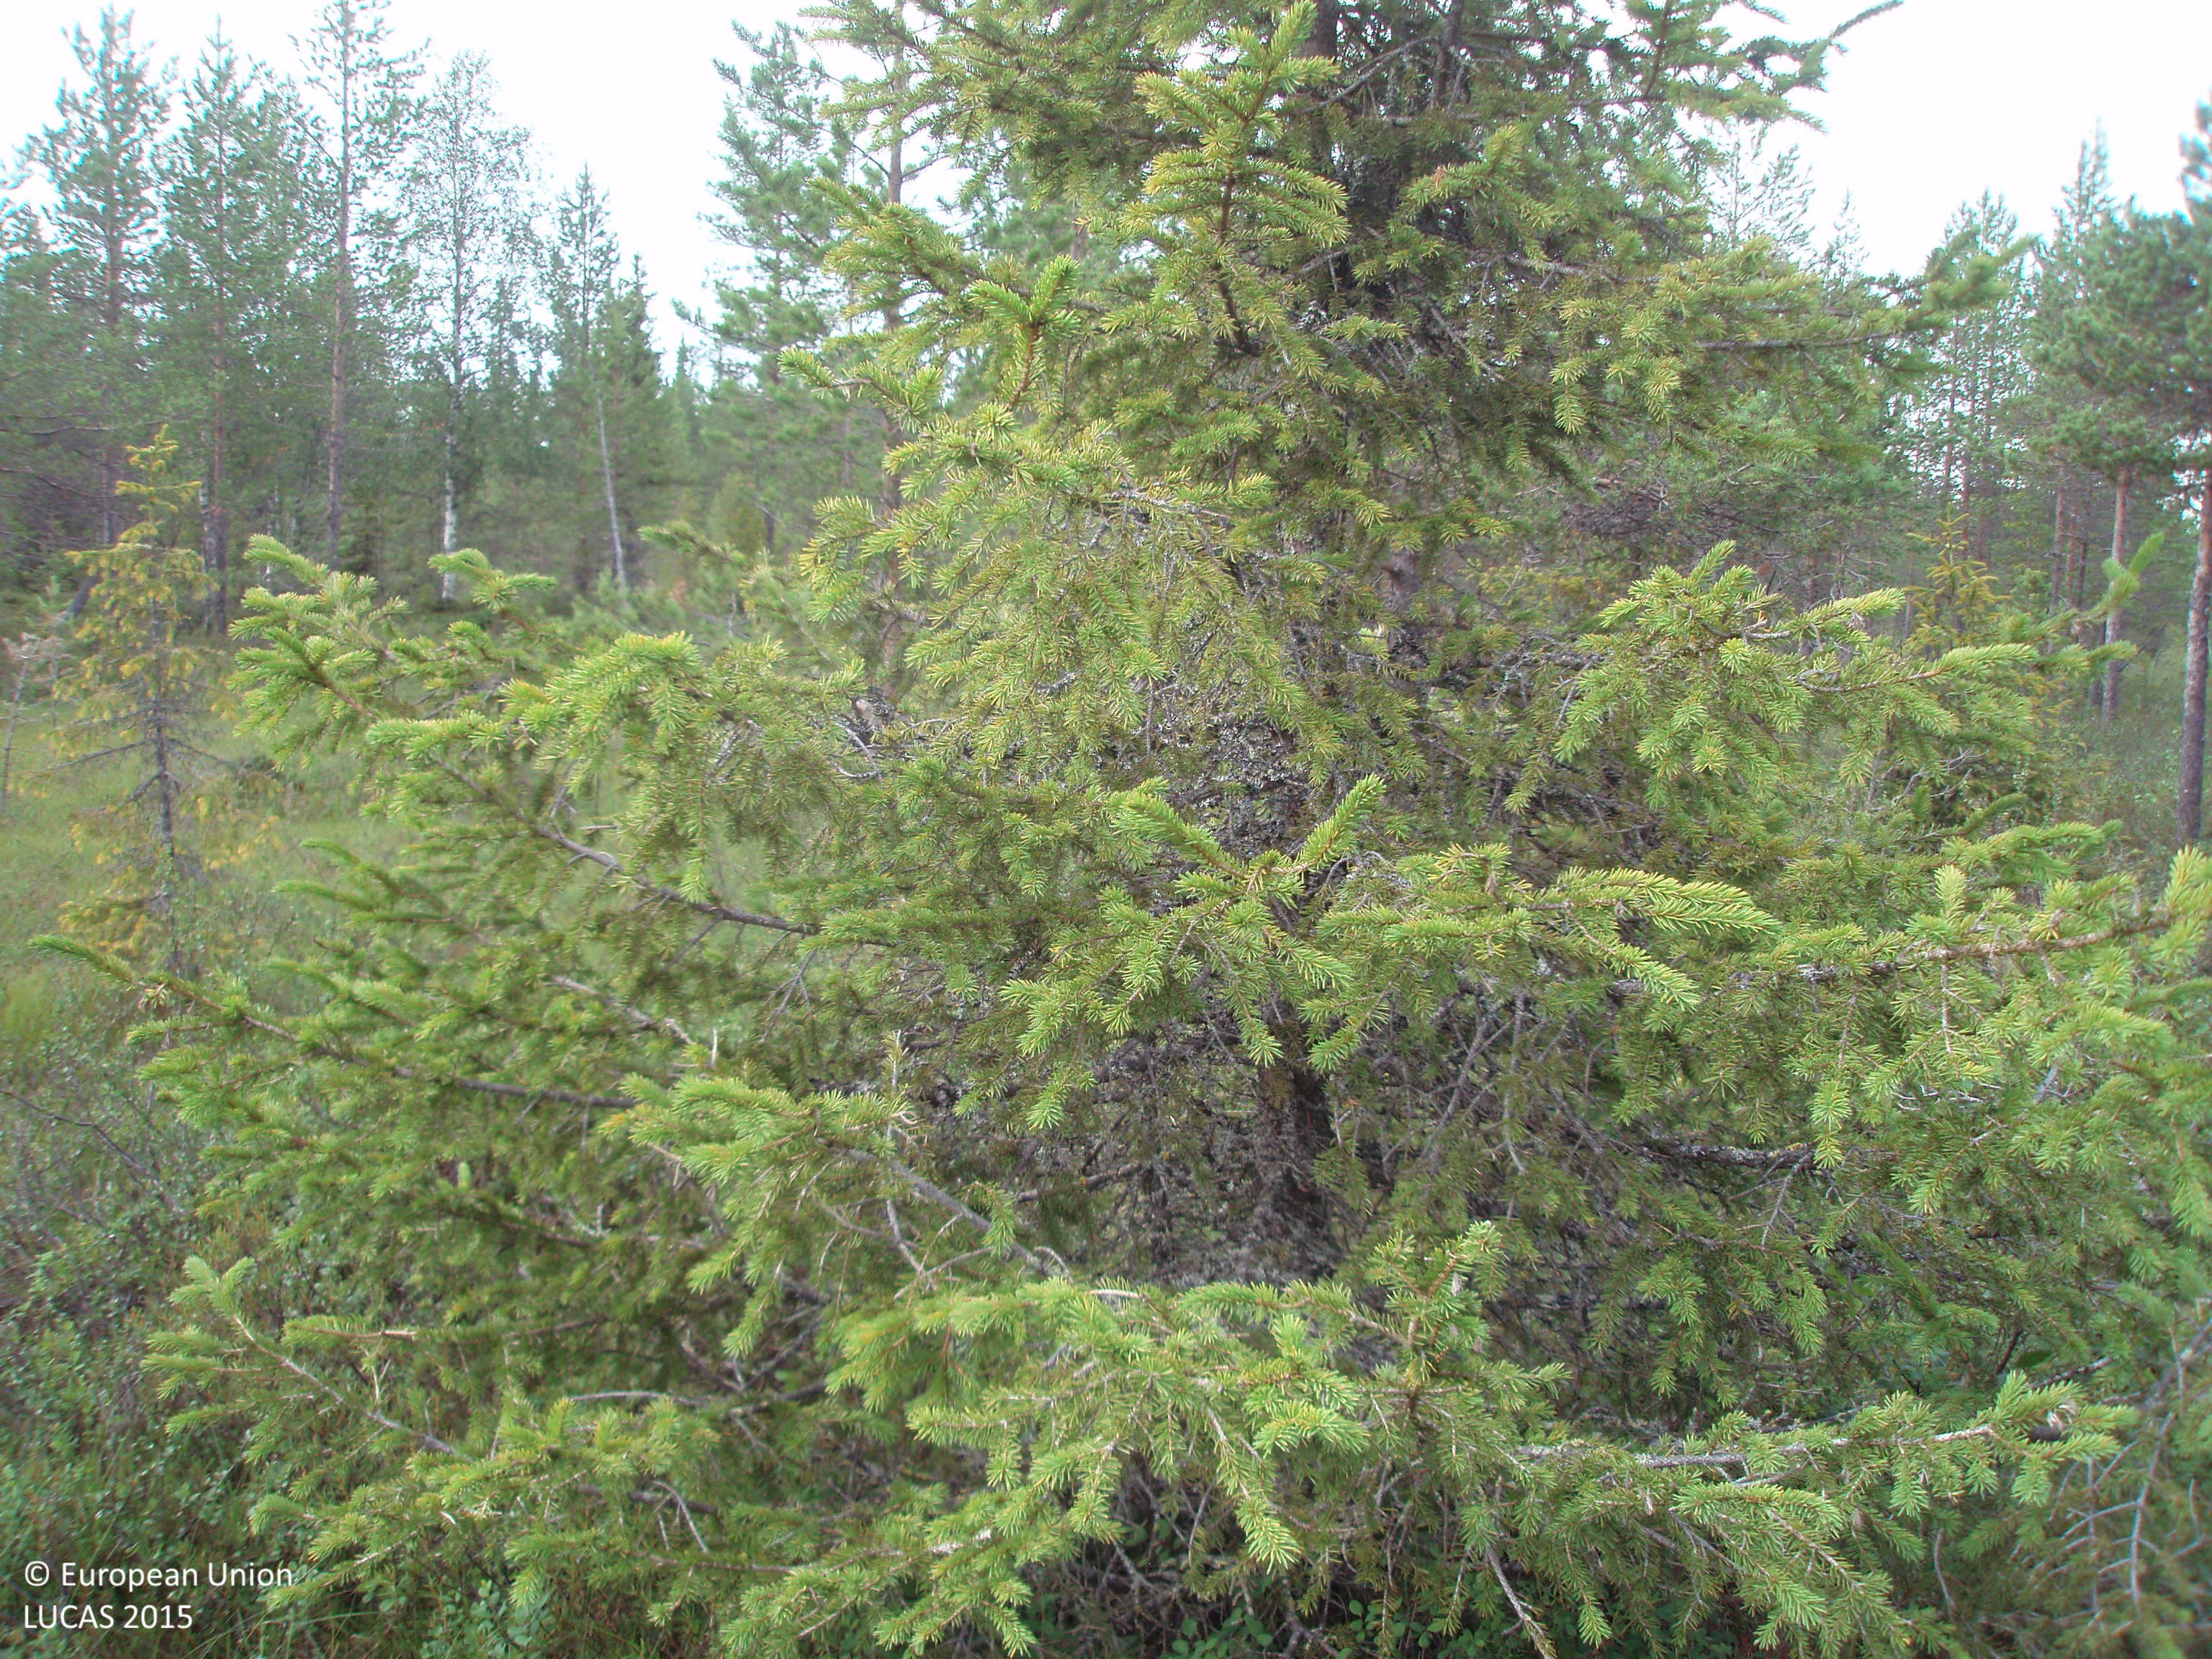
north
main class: Woodland
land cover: Pine dominated coniferous woodland
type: mire and swamp forests
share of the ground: 50 - 75 %
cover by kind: coniferous forest trees 60 %, shrubs 30 %, lichens and mosses 10 %
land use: Semi-natural and natural areas not in use
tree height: > 5 m
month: July
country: FI
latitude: 65.8430
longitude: 27.9416
